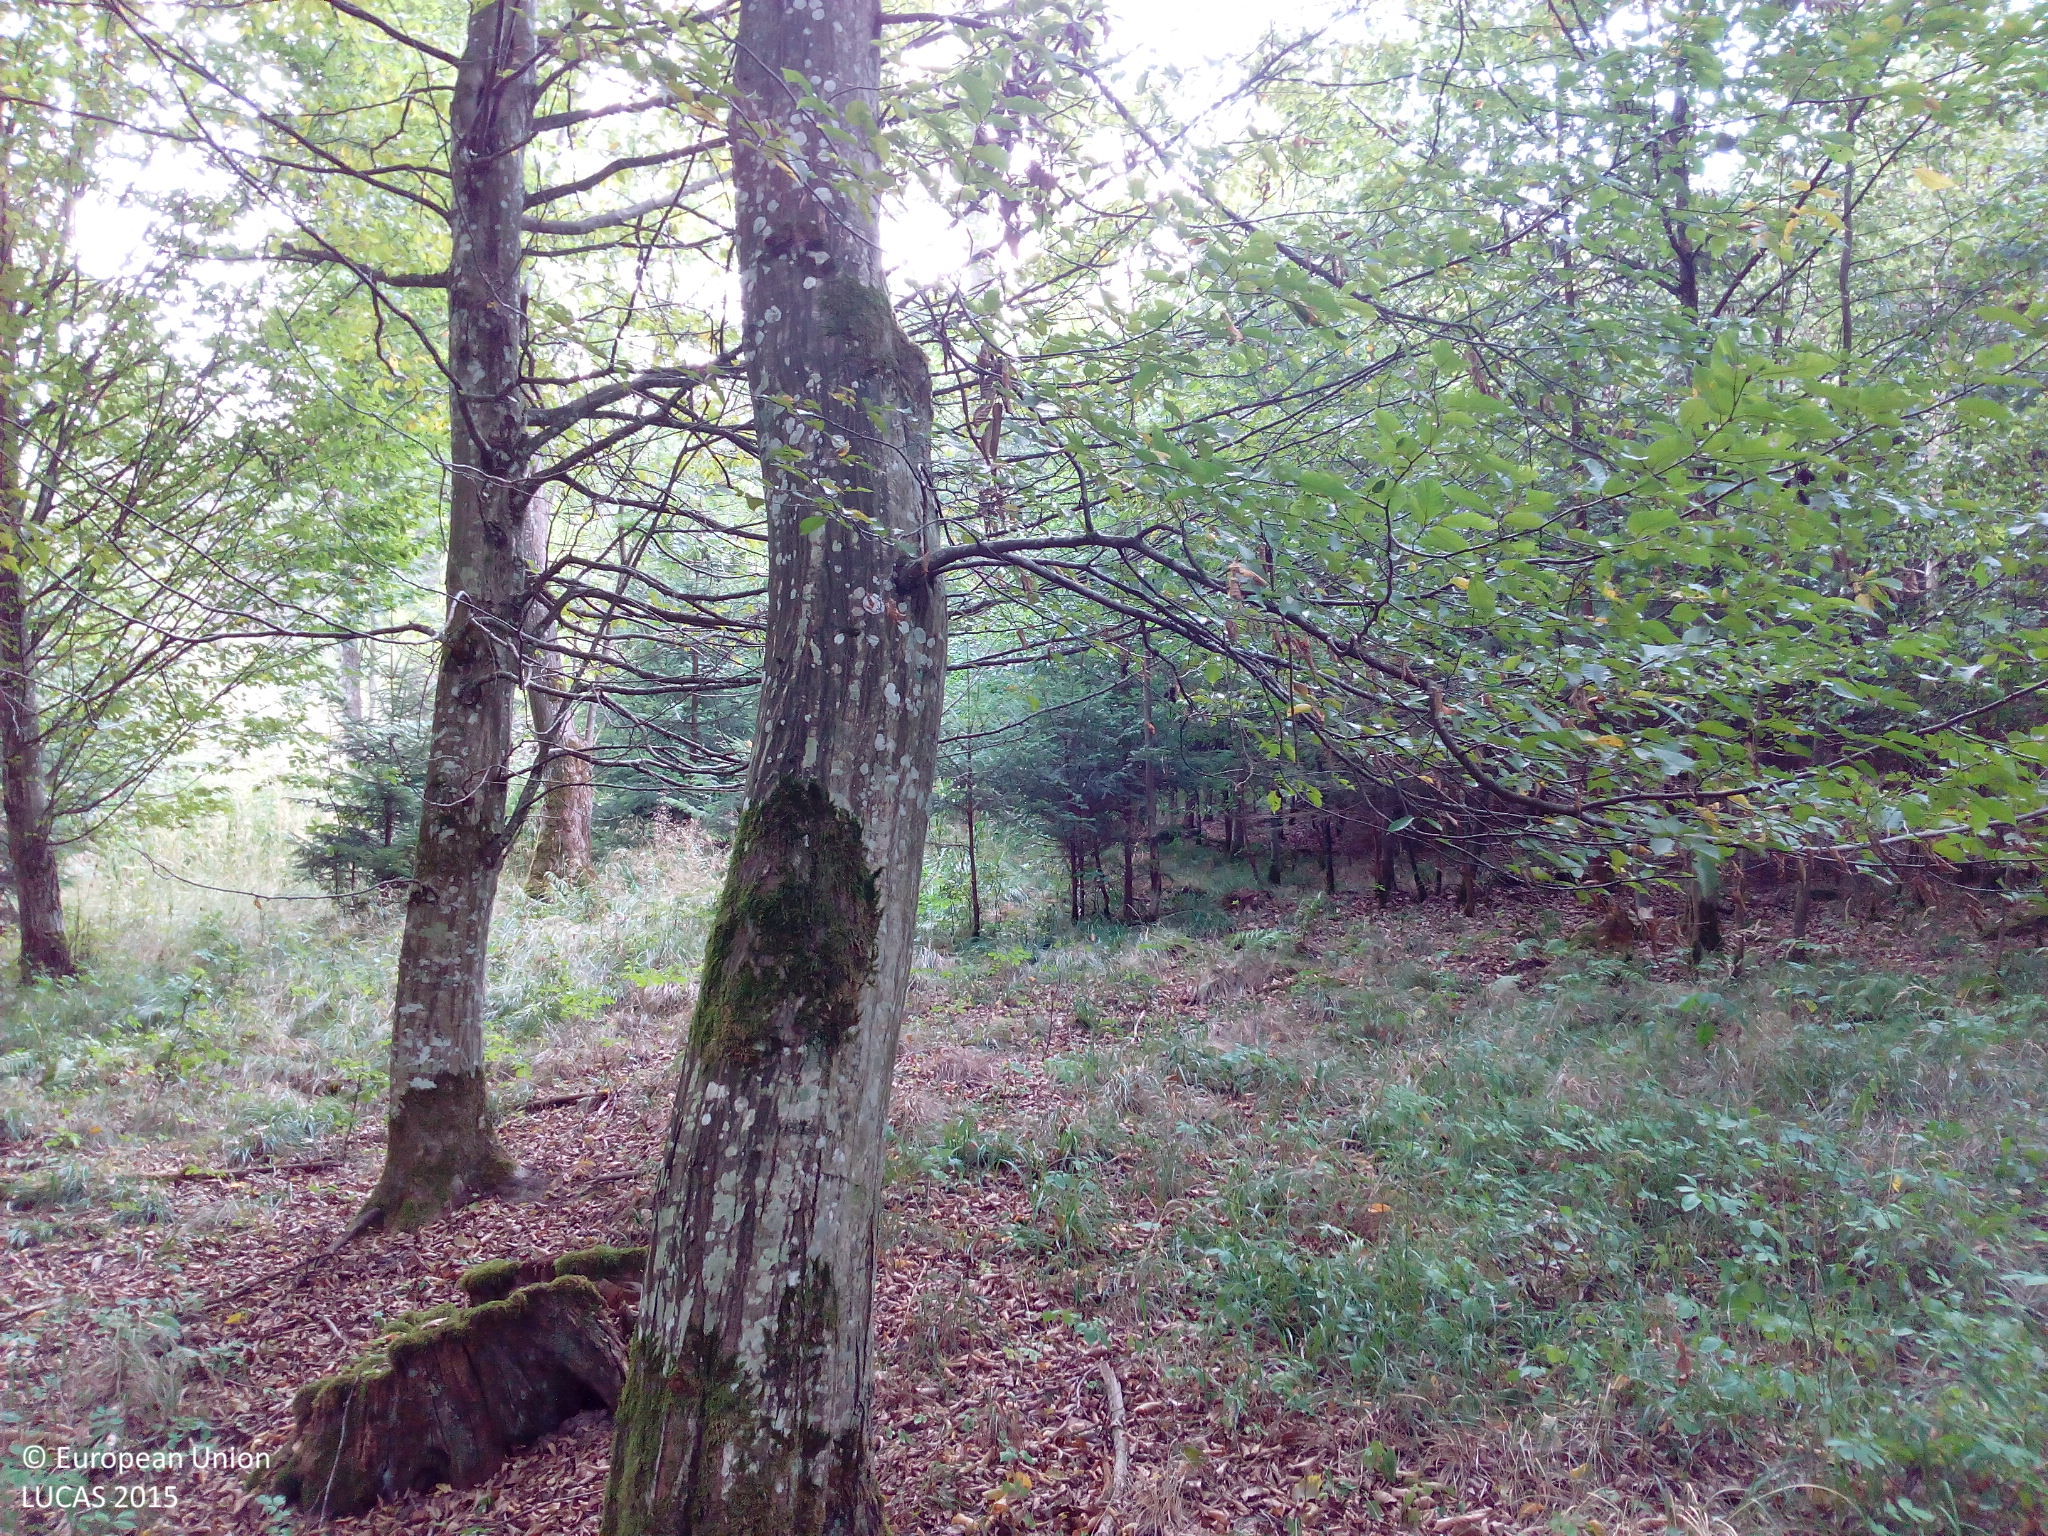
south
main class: Woodland
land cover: Broadleaved woodland
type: mesophytic deciduous forest
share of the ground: > 75 %
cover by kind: broadleaved forest trees 80 %, coniferous forest trees 10 %, unconsolidated bare surface 10 %
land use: Forestry
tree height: > 5 m
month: September
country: DE
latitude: 48.6721
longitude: 10.5293
